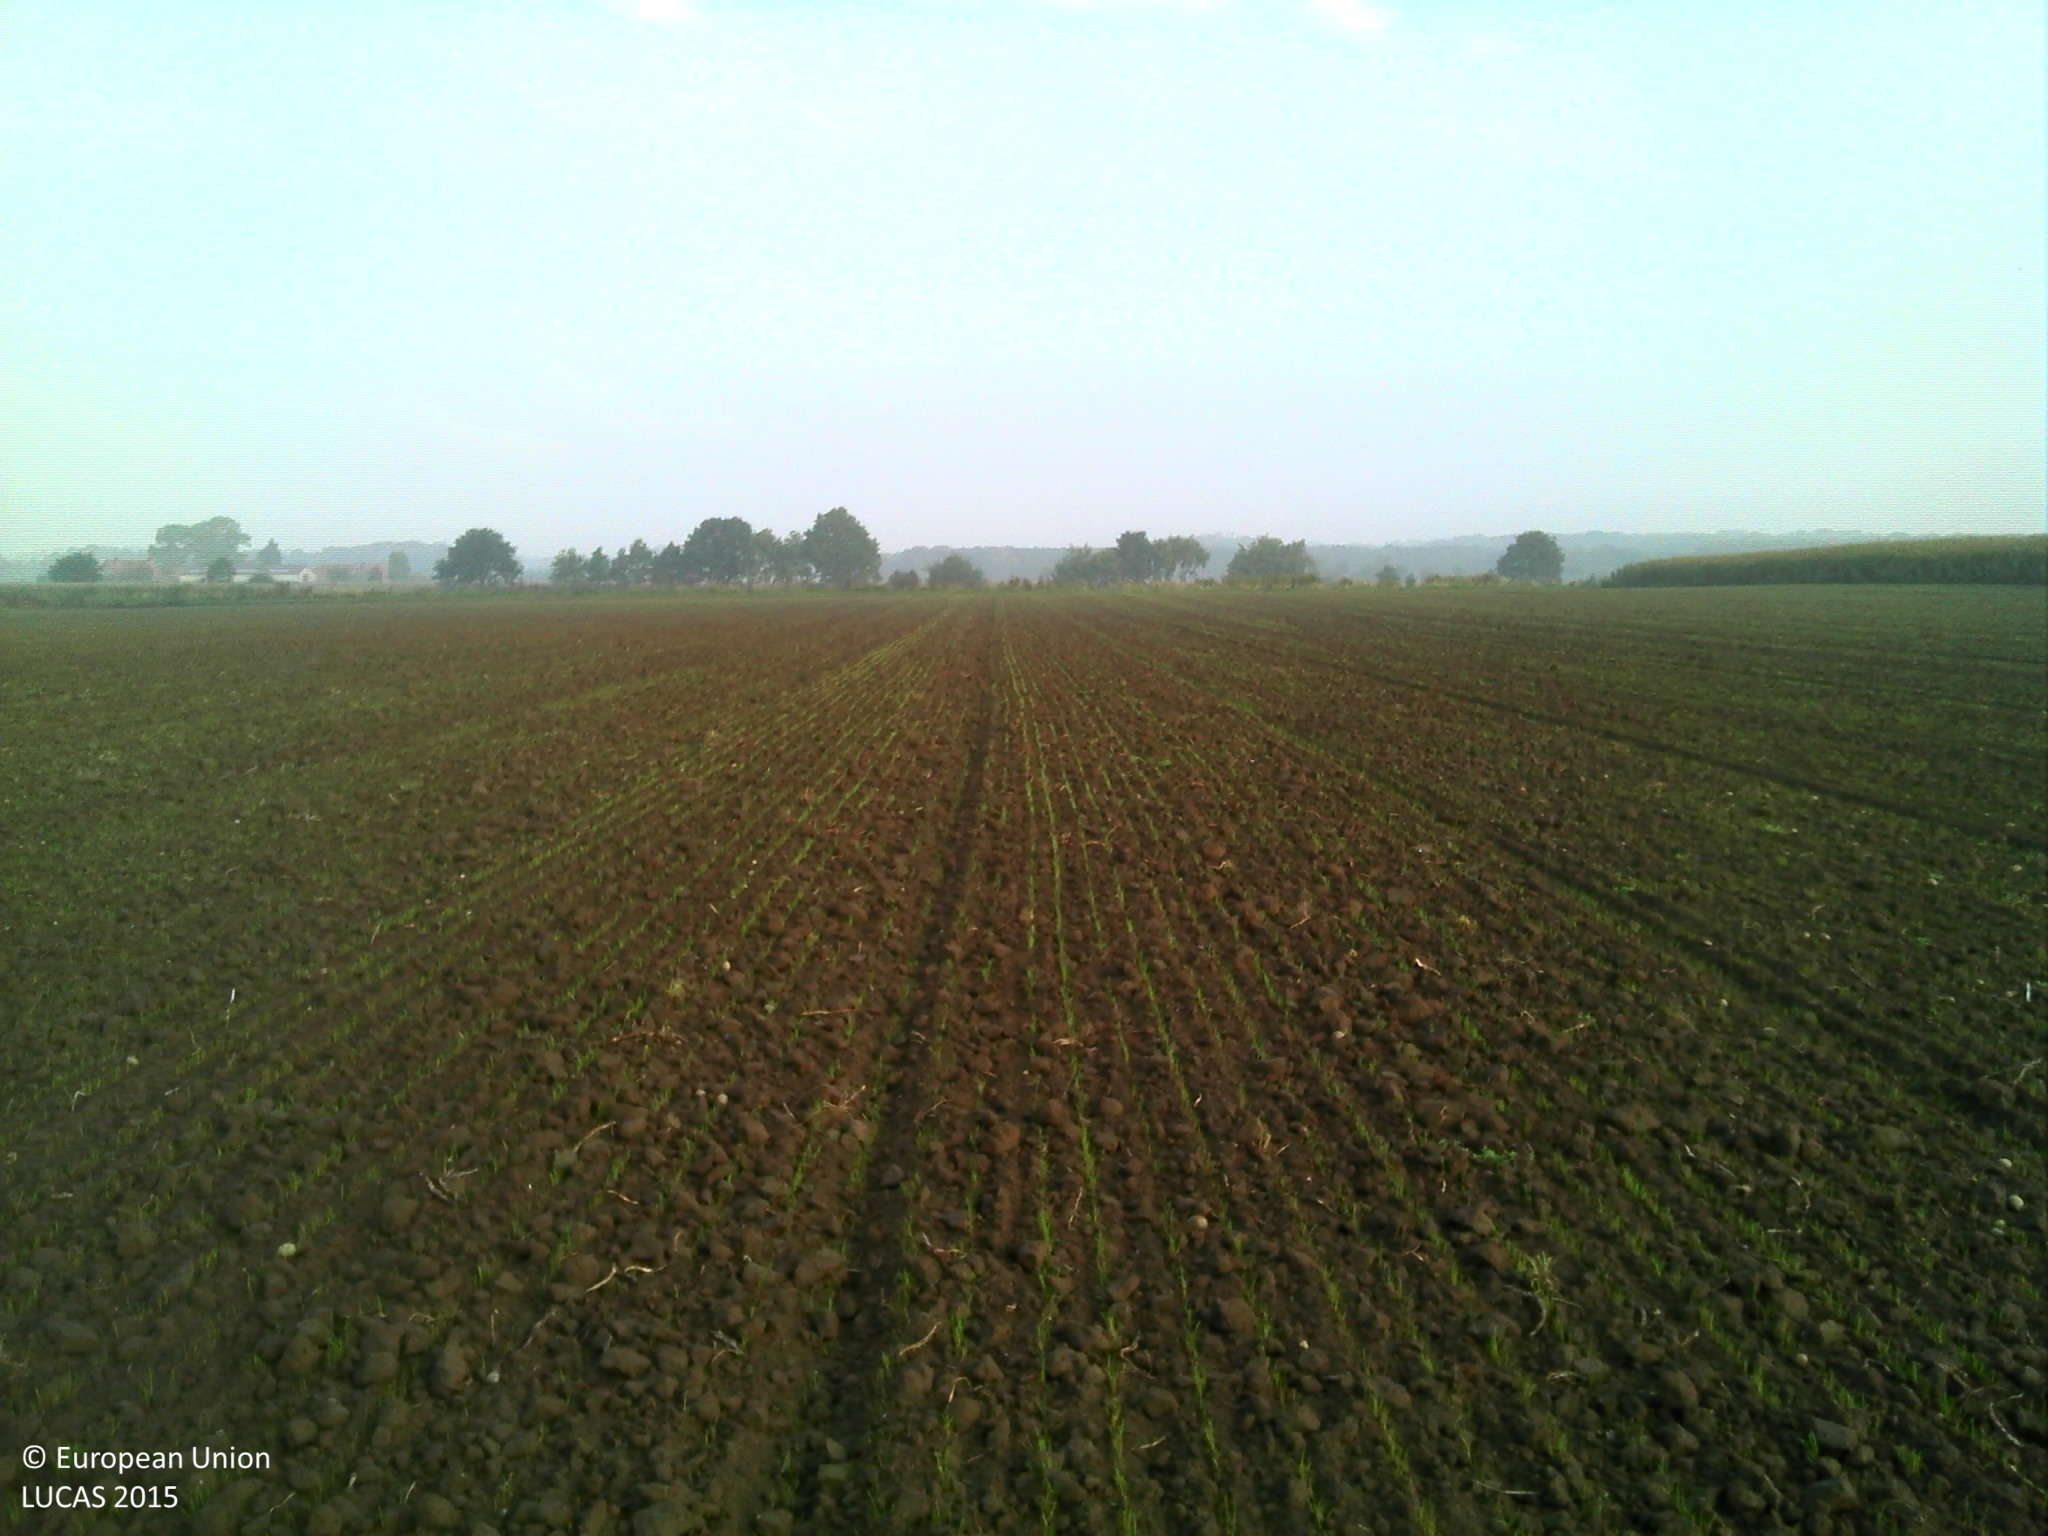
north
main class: Cropland
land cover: Temporary grasslands
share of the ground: < 10 %
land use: Agriculture (excluding fallow land and kitchen gardens)
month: October
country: BE
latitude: 50.9403
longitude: 2.9451
